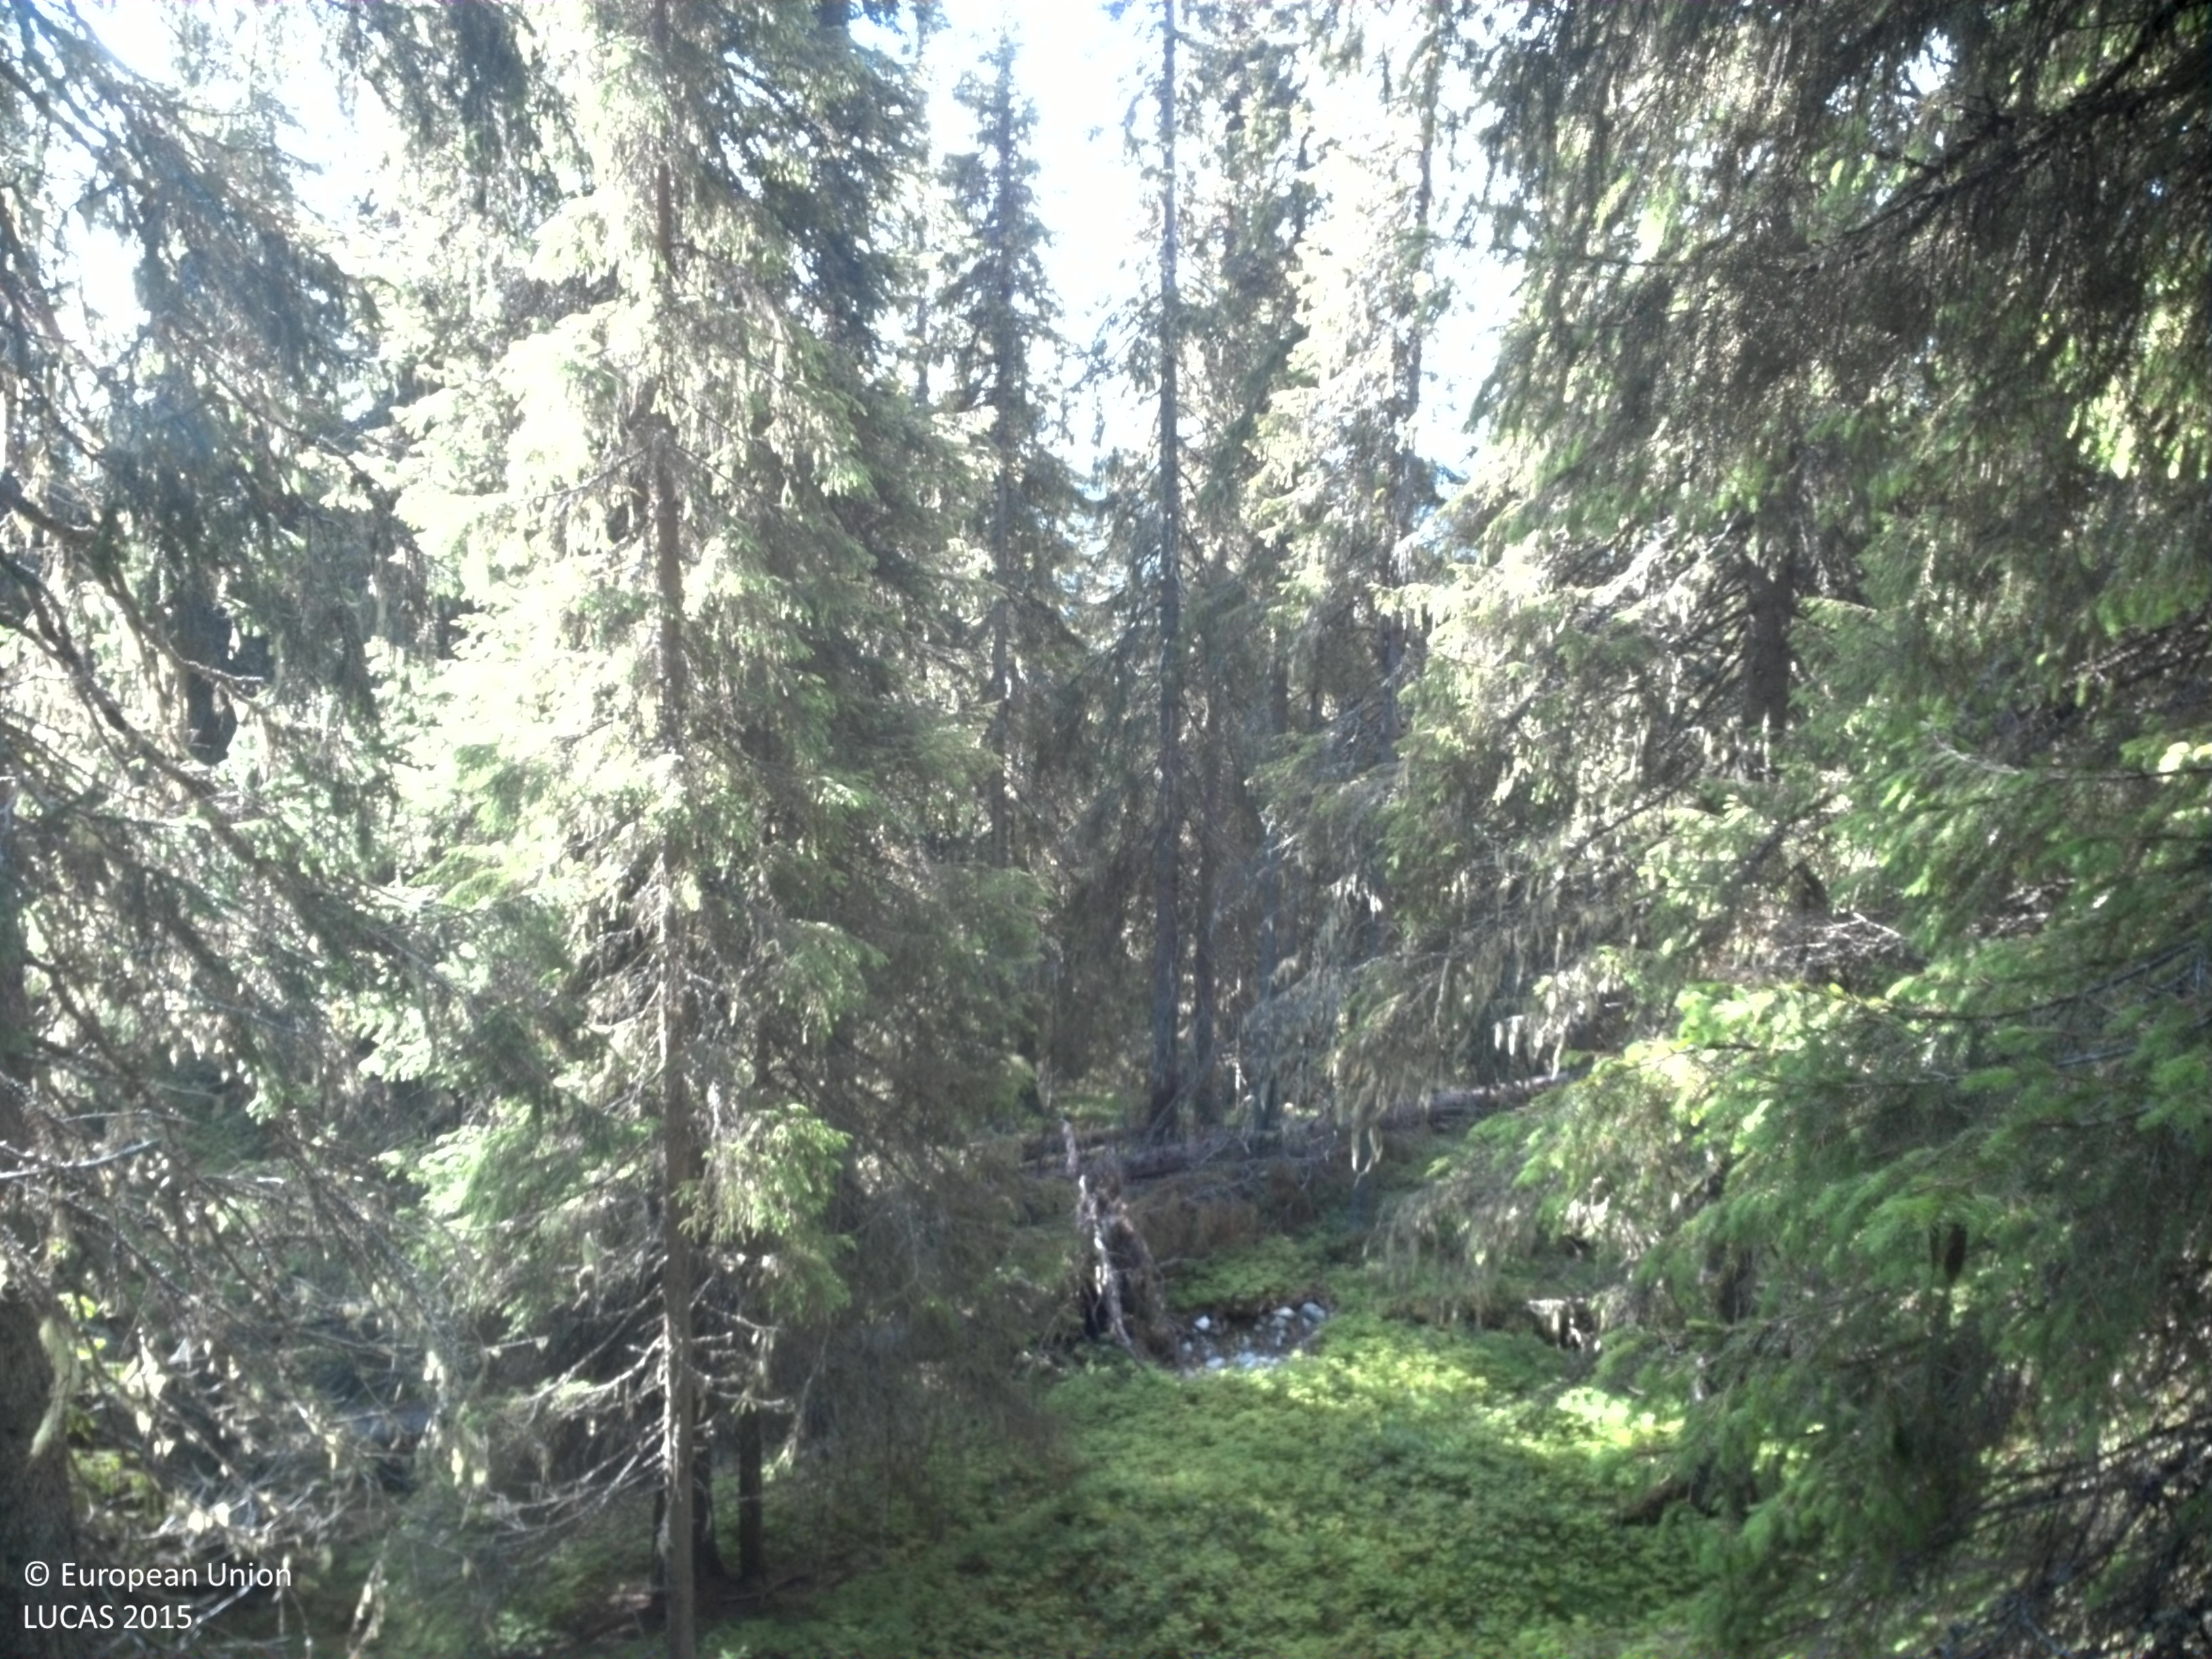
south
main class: Woodland
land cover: Spruce dominated coniferous woodland
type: boreal forest
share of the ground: 50 - 75 %
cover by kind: coniferous forest trees 60 %, shrubs 20 %, lichens and mosses 15 %, herbaceous plants 5 %
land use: Forestry
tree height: > 5 m
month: September
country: SE
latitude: 65.0255
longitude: 16.5236
